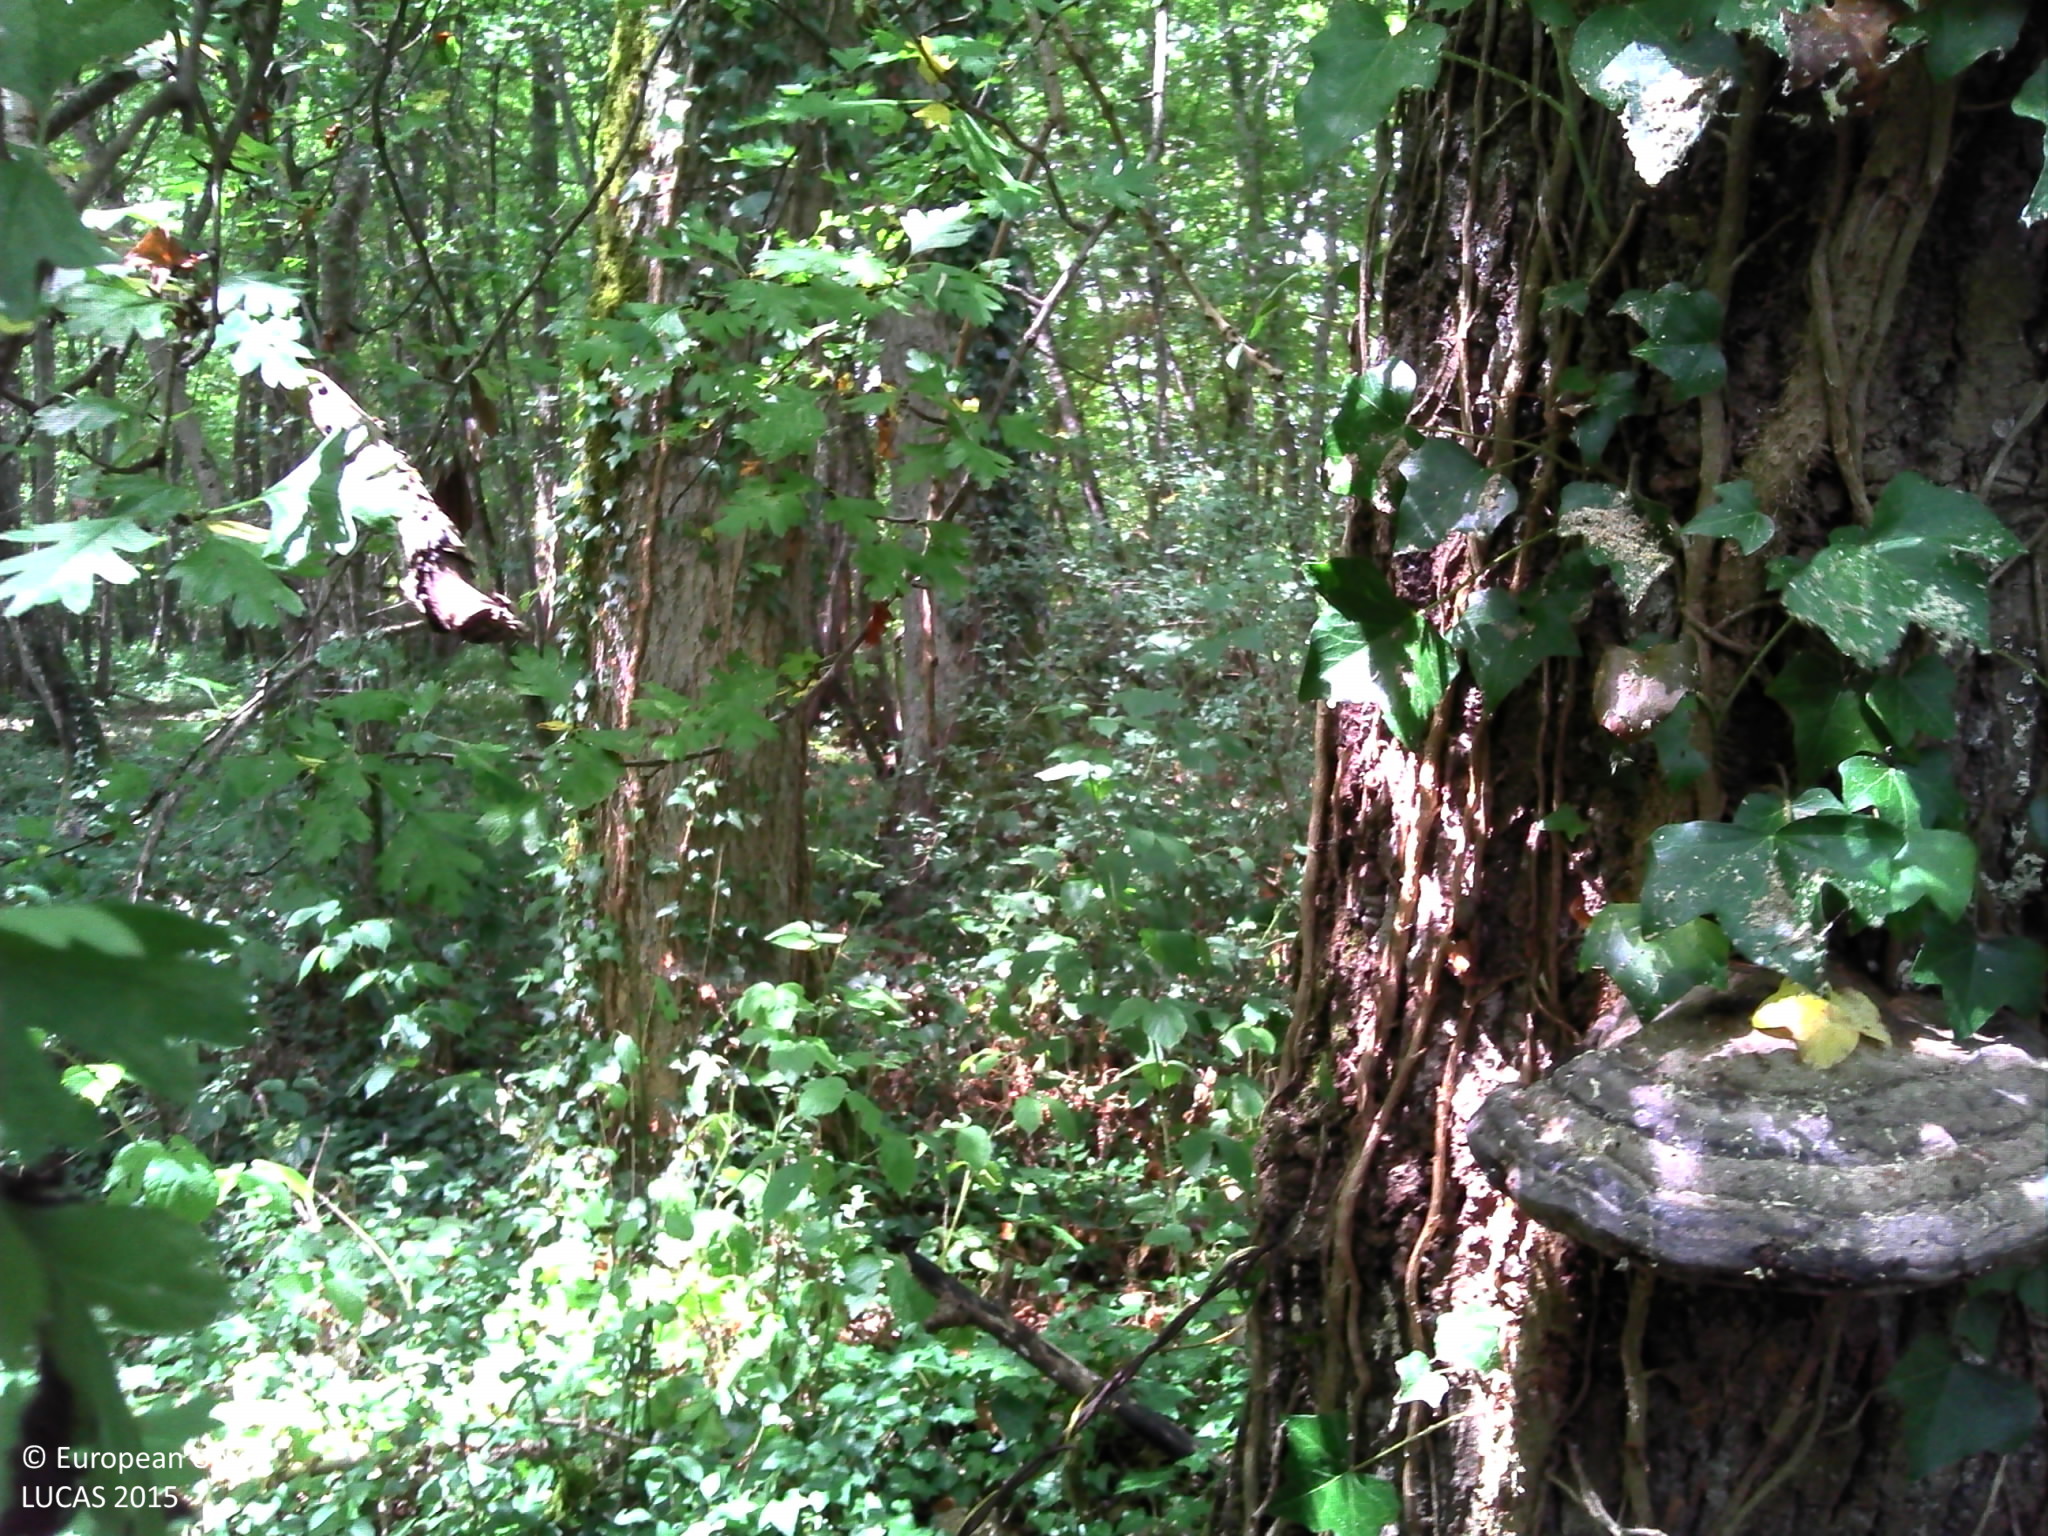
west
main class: Woodland
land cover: Broadleaved woodland
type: mesophytic deciduous forest
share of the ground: > 75 %
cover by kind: broadleaved forest trees 90 %, herbaceous plants 5 %, lichens and mosses 5 %
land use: Forestry
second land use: Amenities, museums, leisure
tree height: > 5 m
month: July
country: FR
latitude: 48.1337
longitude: 3.0997
